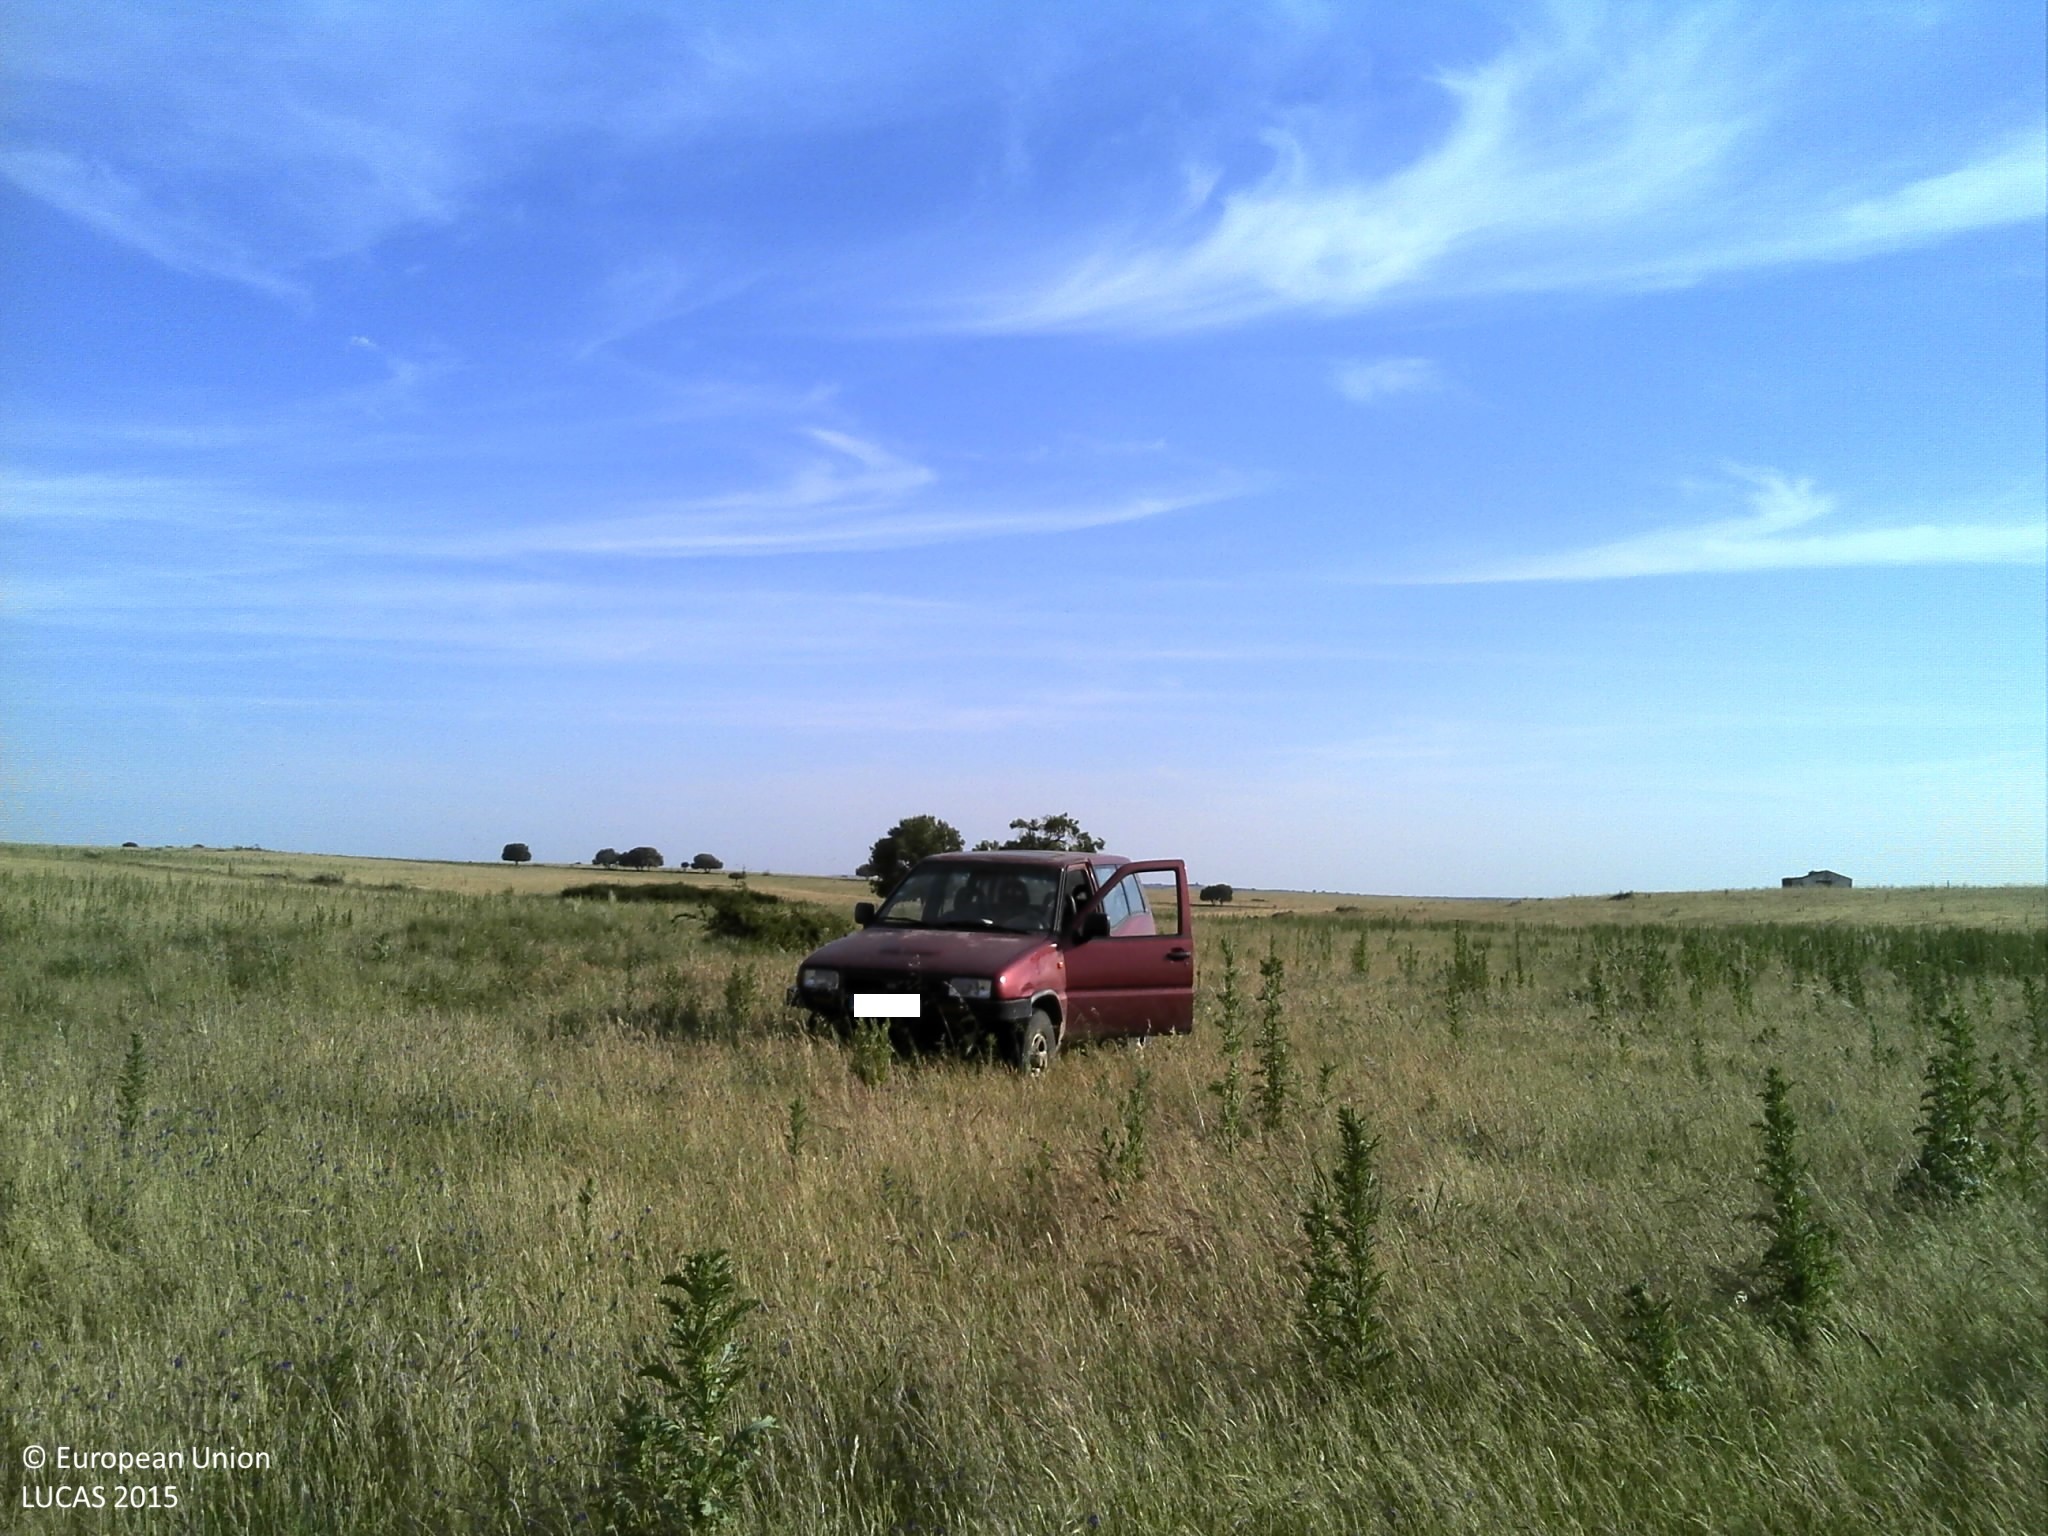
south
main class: Grassland
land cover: Grassland without tree/shrub cover
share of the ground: > 75 %
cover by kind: herbaceous plants 90 %, unconsolidated bare surface 10 %
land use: Agriculture (excluding fallow land and kitchen gardens)
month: May
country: PT
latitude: 39.1659
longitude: -7.6718
